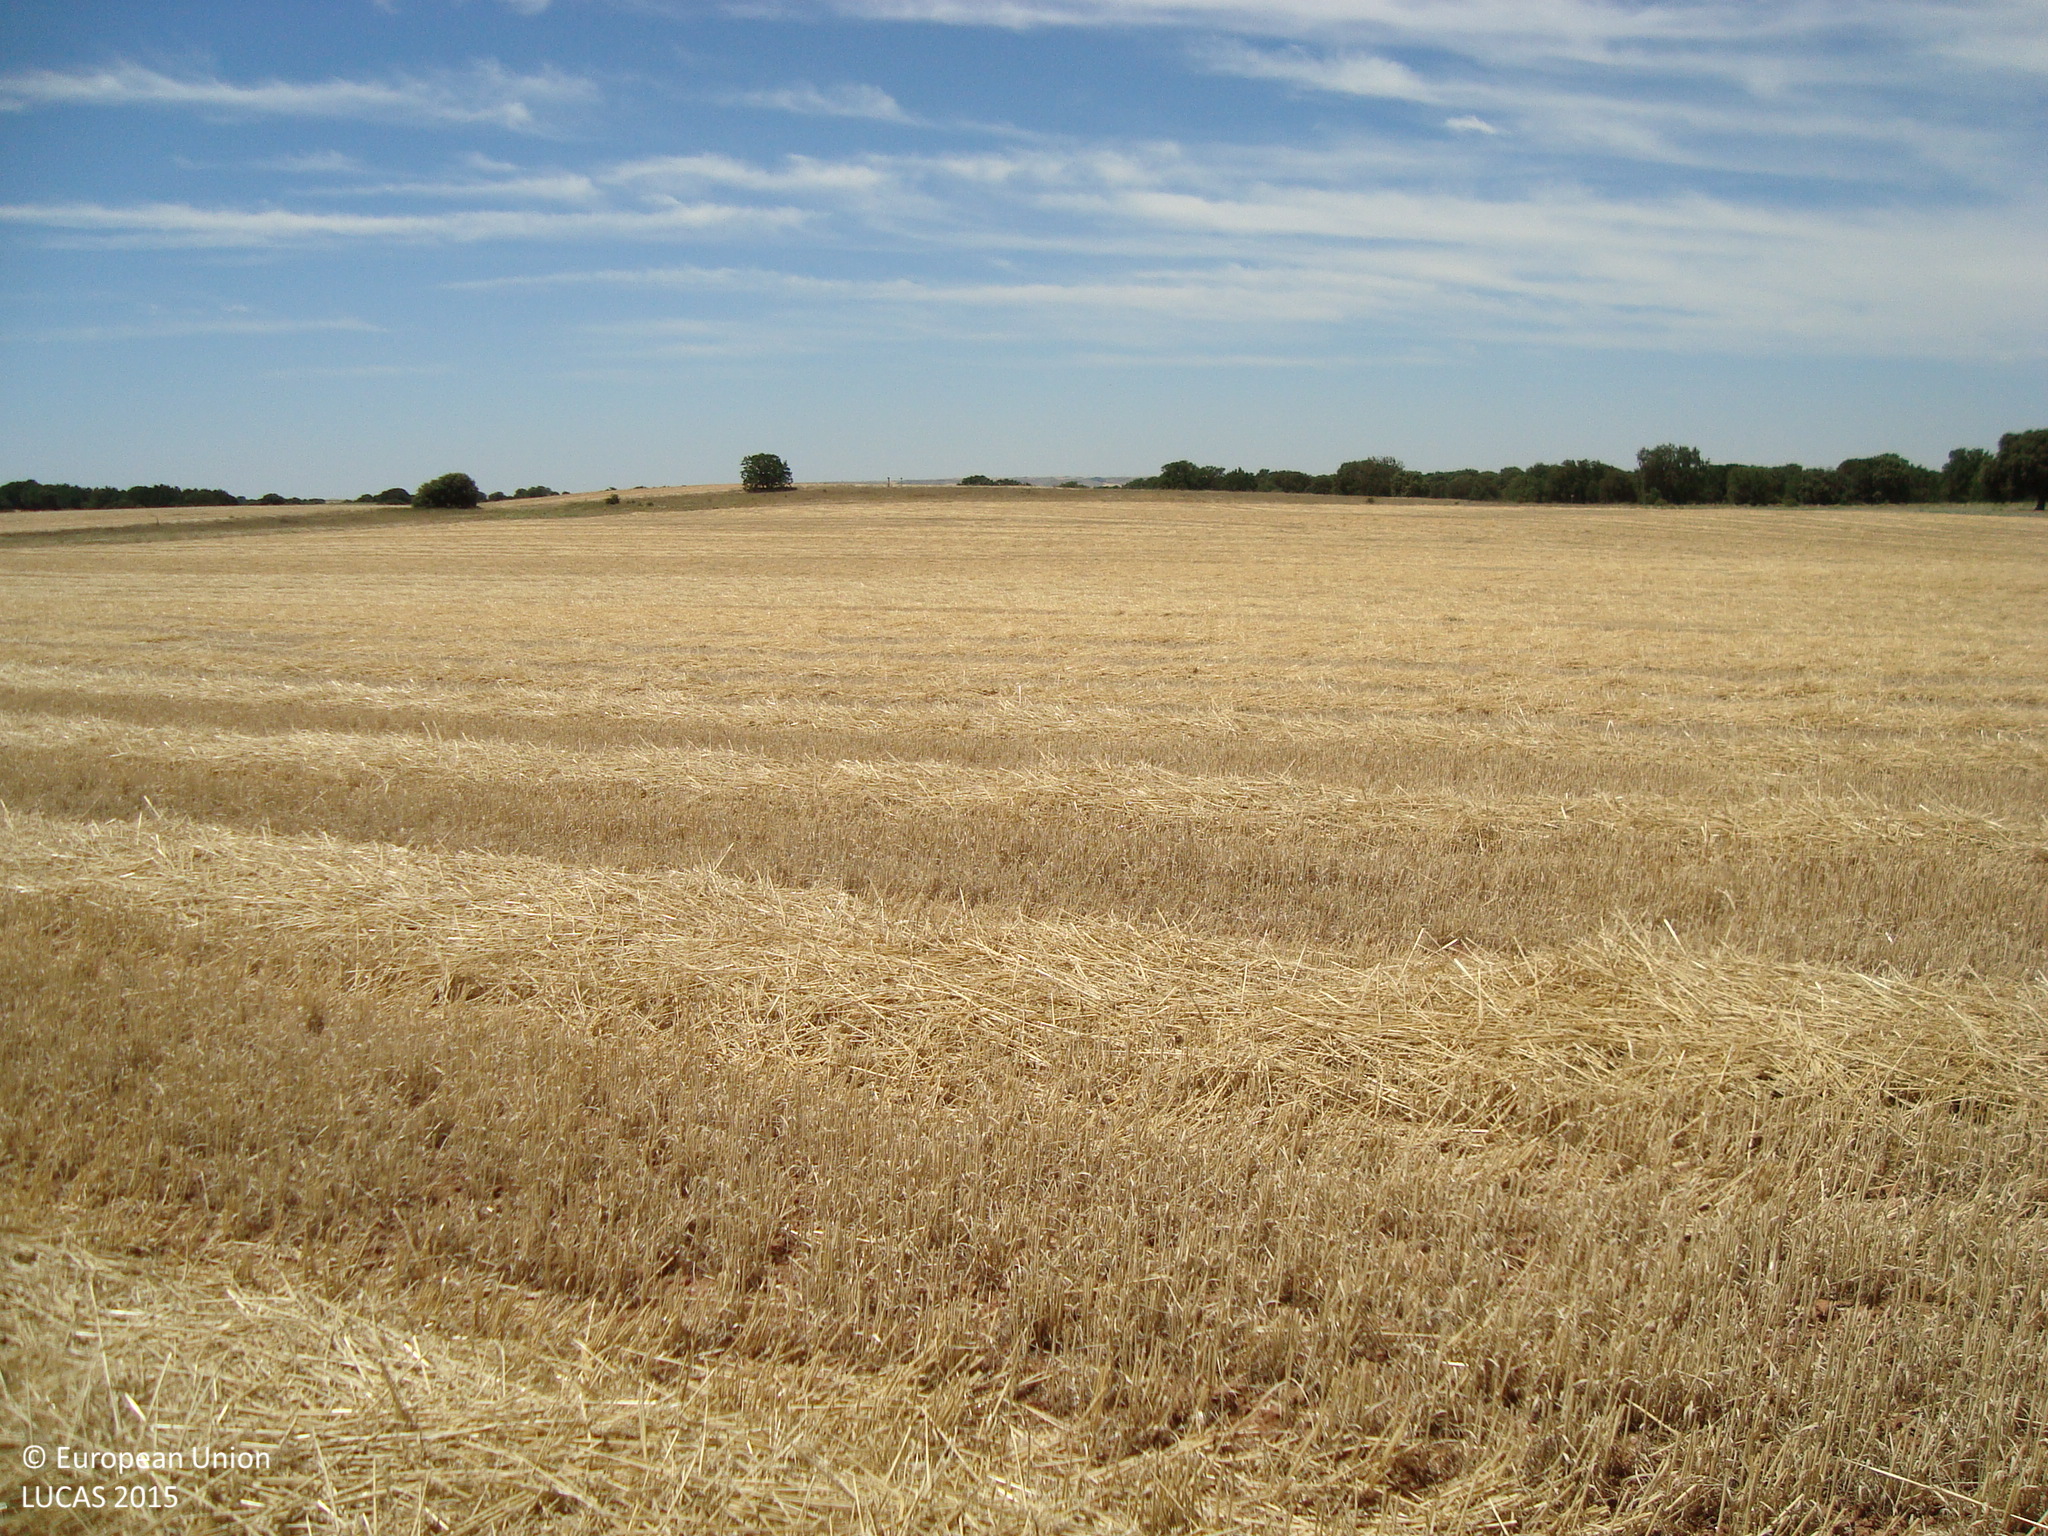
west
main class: Cropland
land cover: Common wheat
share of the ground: > 75 %
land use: Agriculture (excluding fallow land and kitchen gardens)
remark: Harvested field
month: July
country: ES
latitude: 42.0990
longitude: -3.8567
